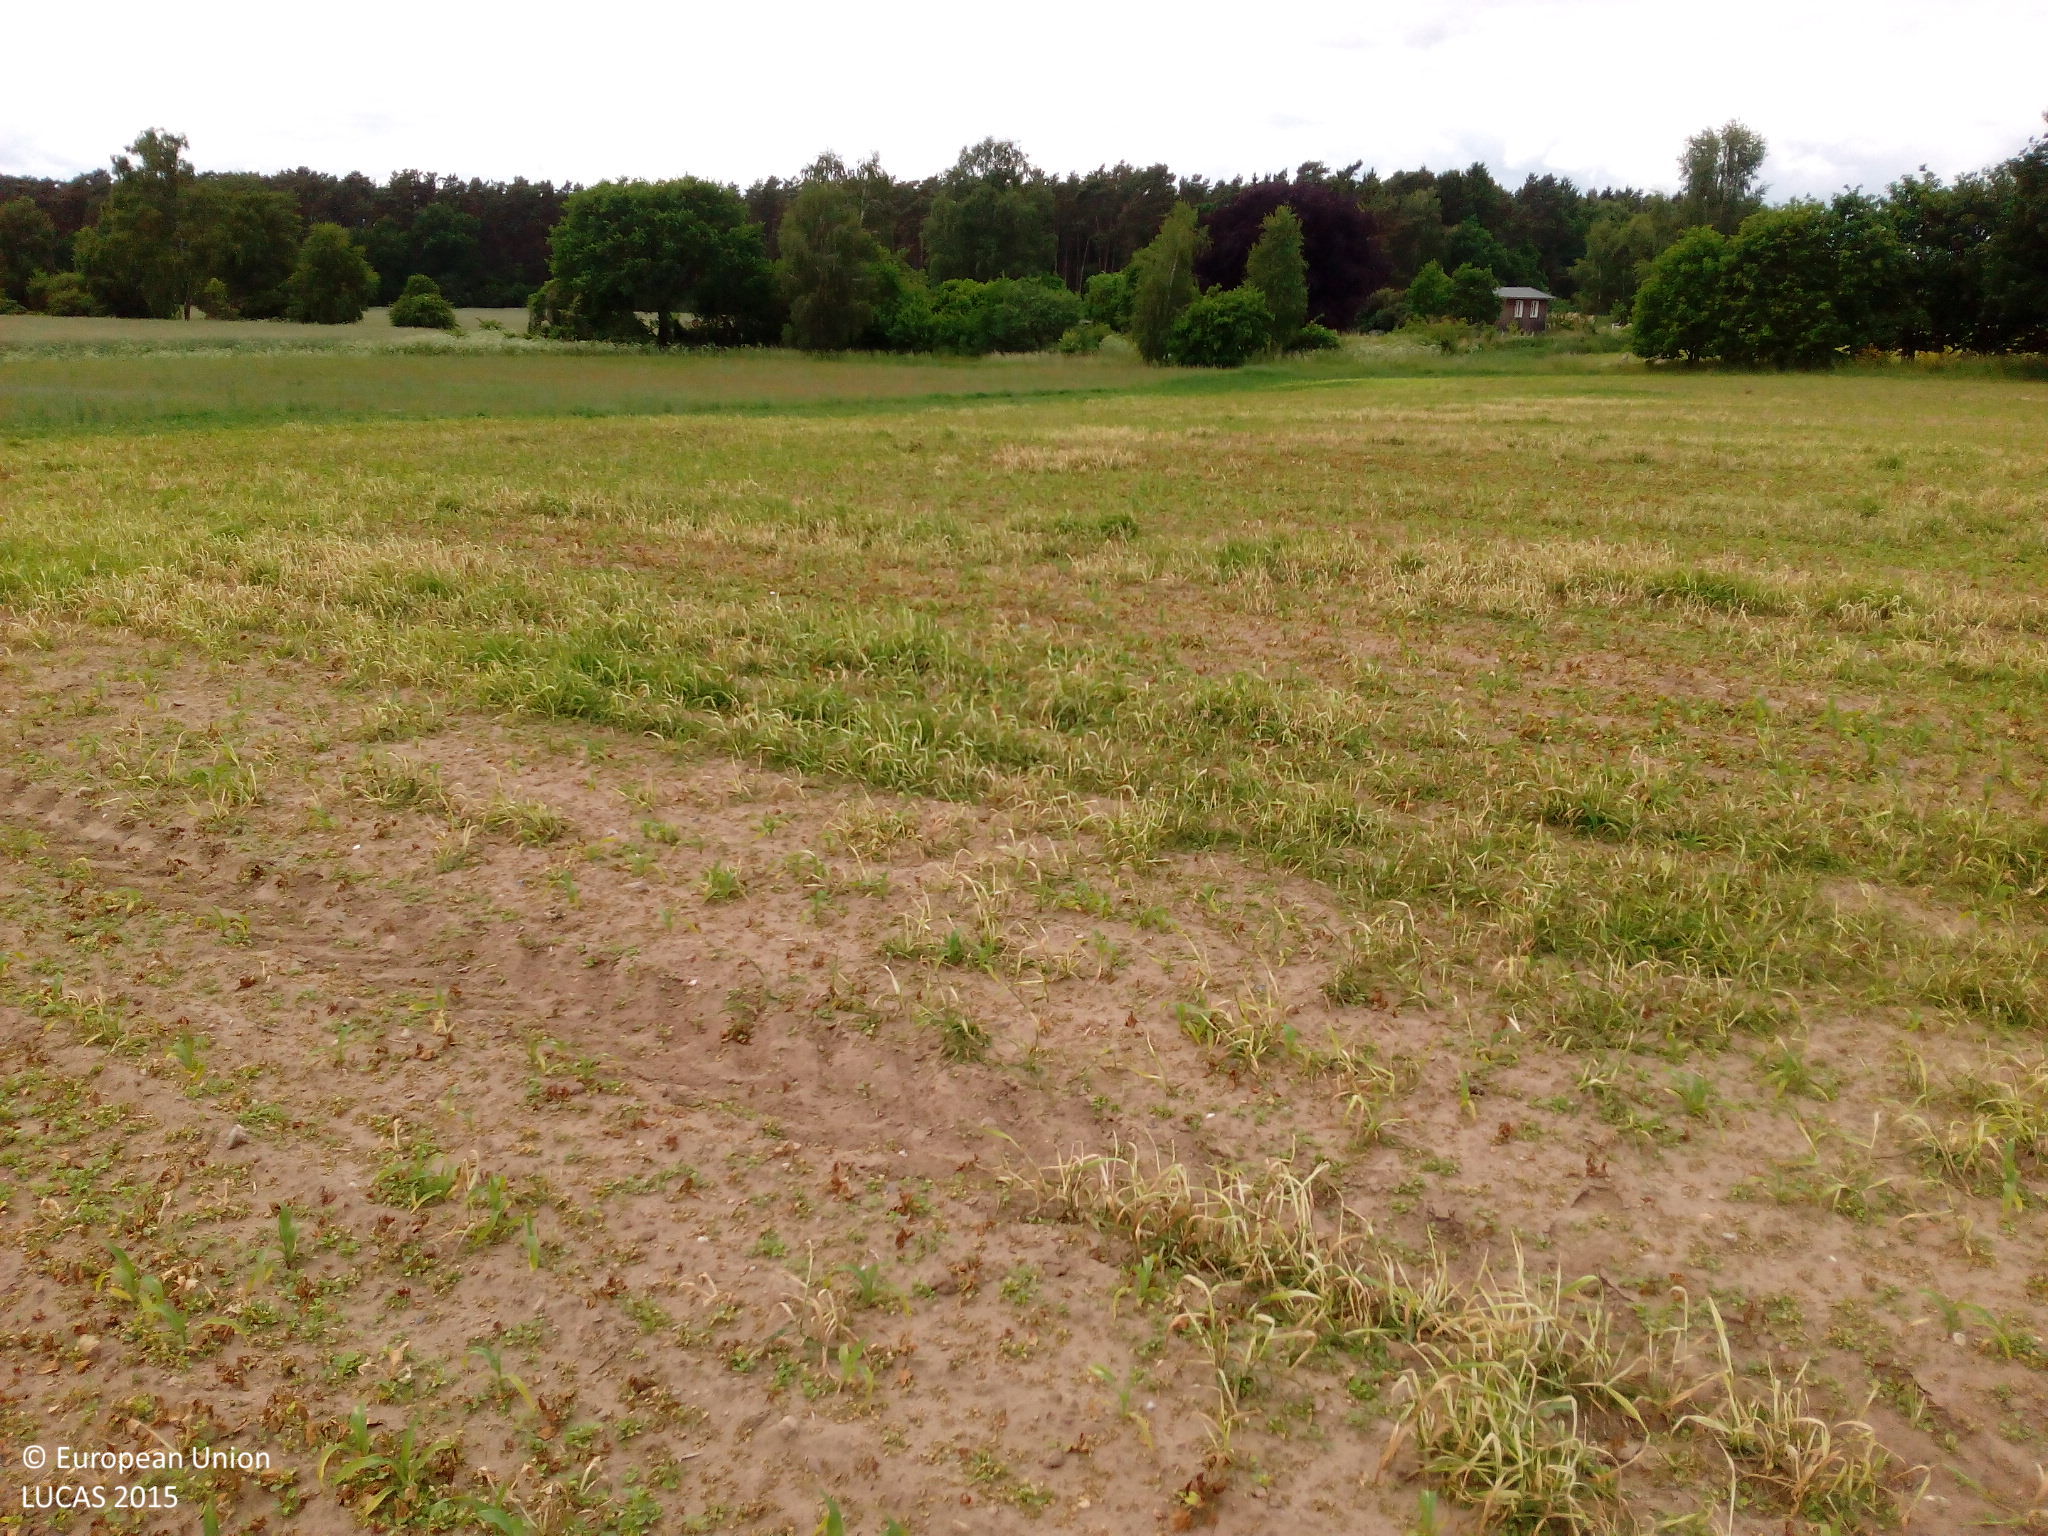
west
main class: Cropland
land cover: Maize
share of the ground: < 10 %
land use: Agriculture (excluding fallow land and kitchen gardens)
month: June
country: DE
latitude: 53.3969
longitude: 12.3604
